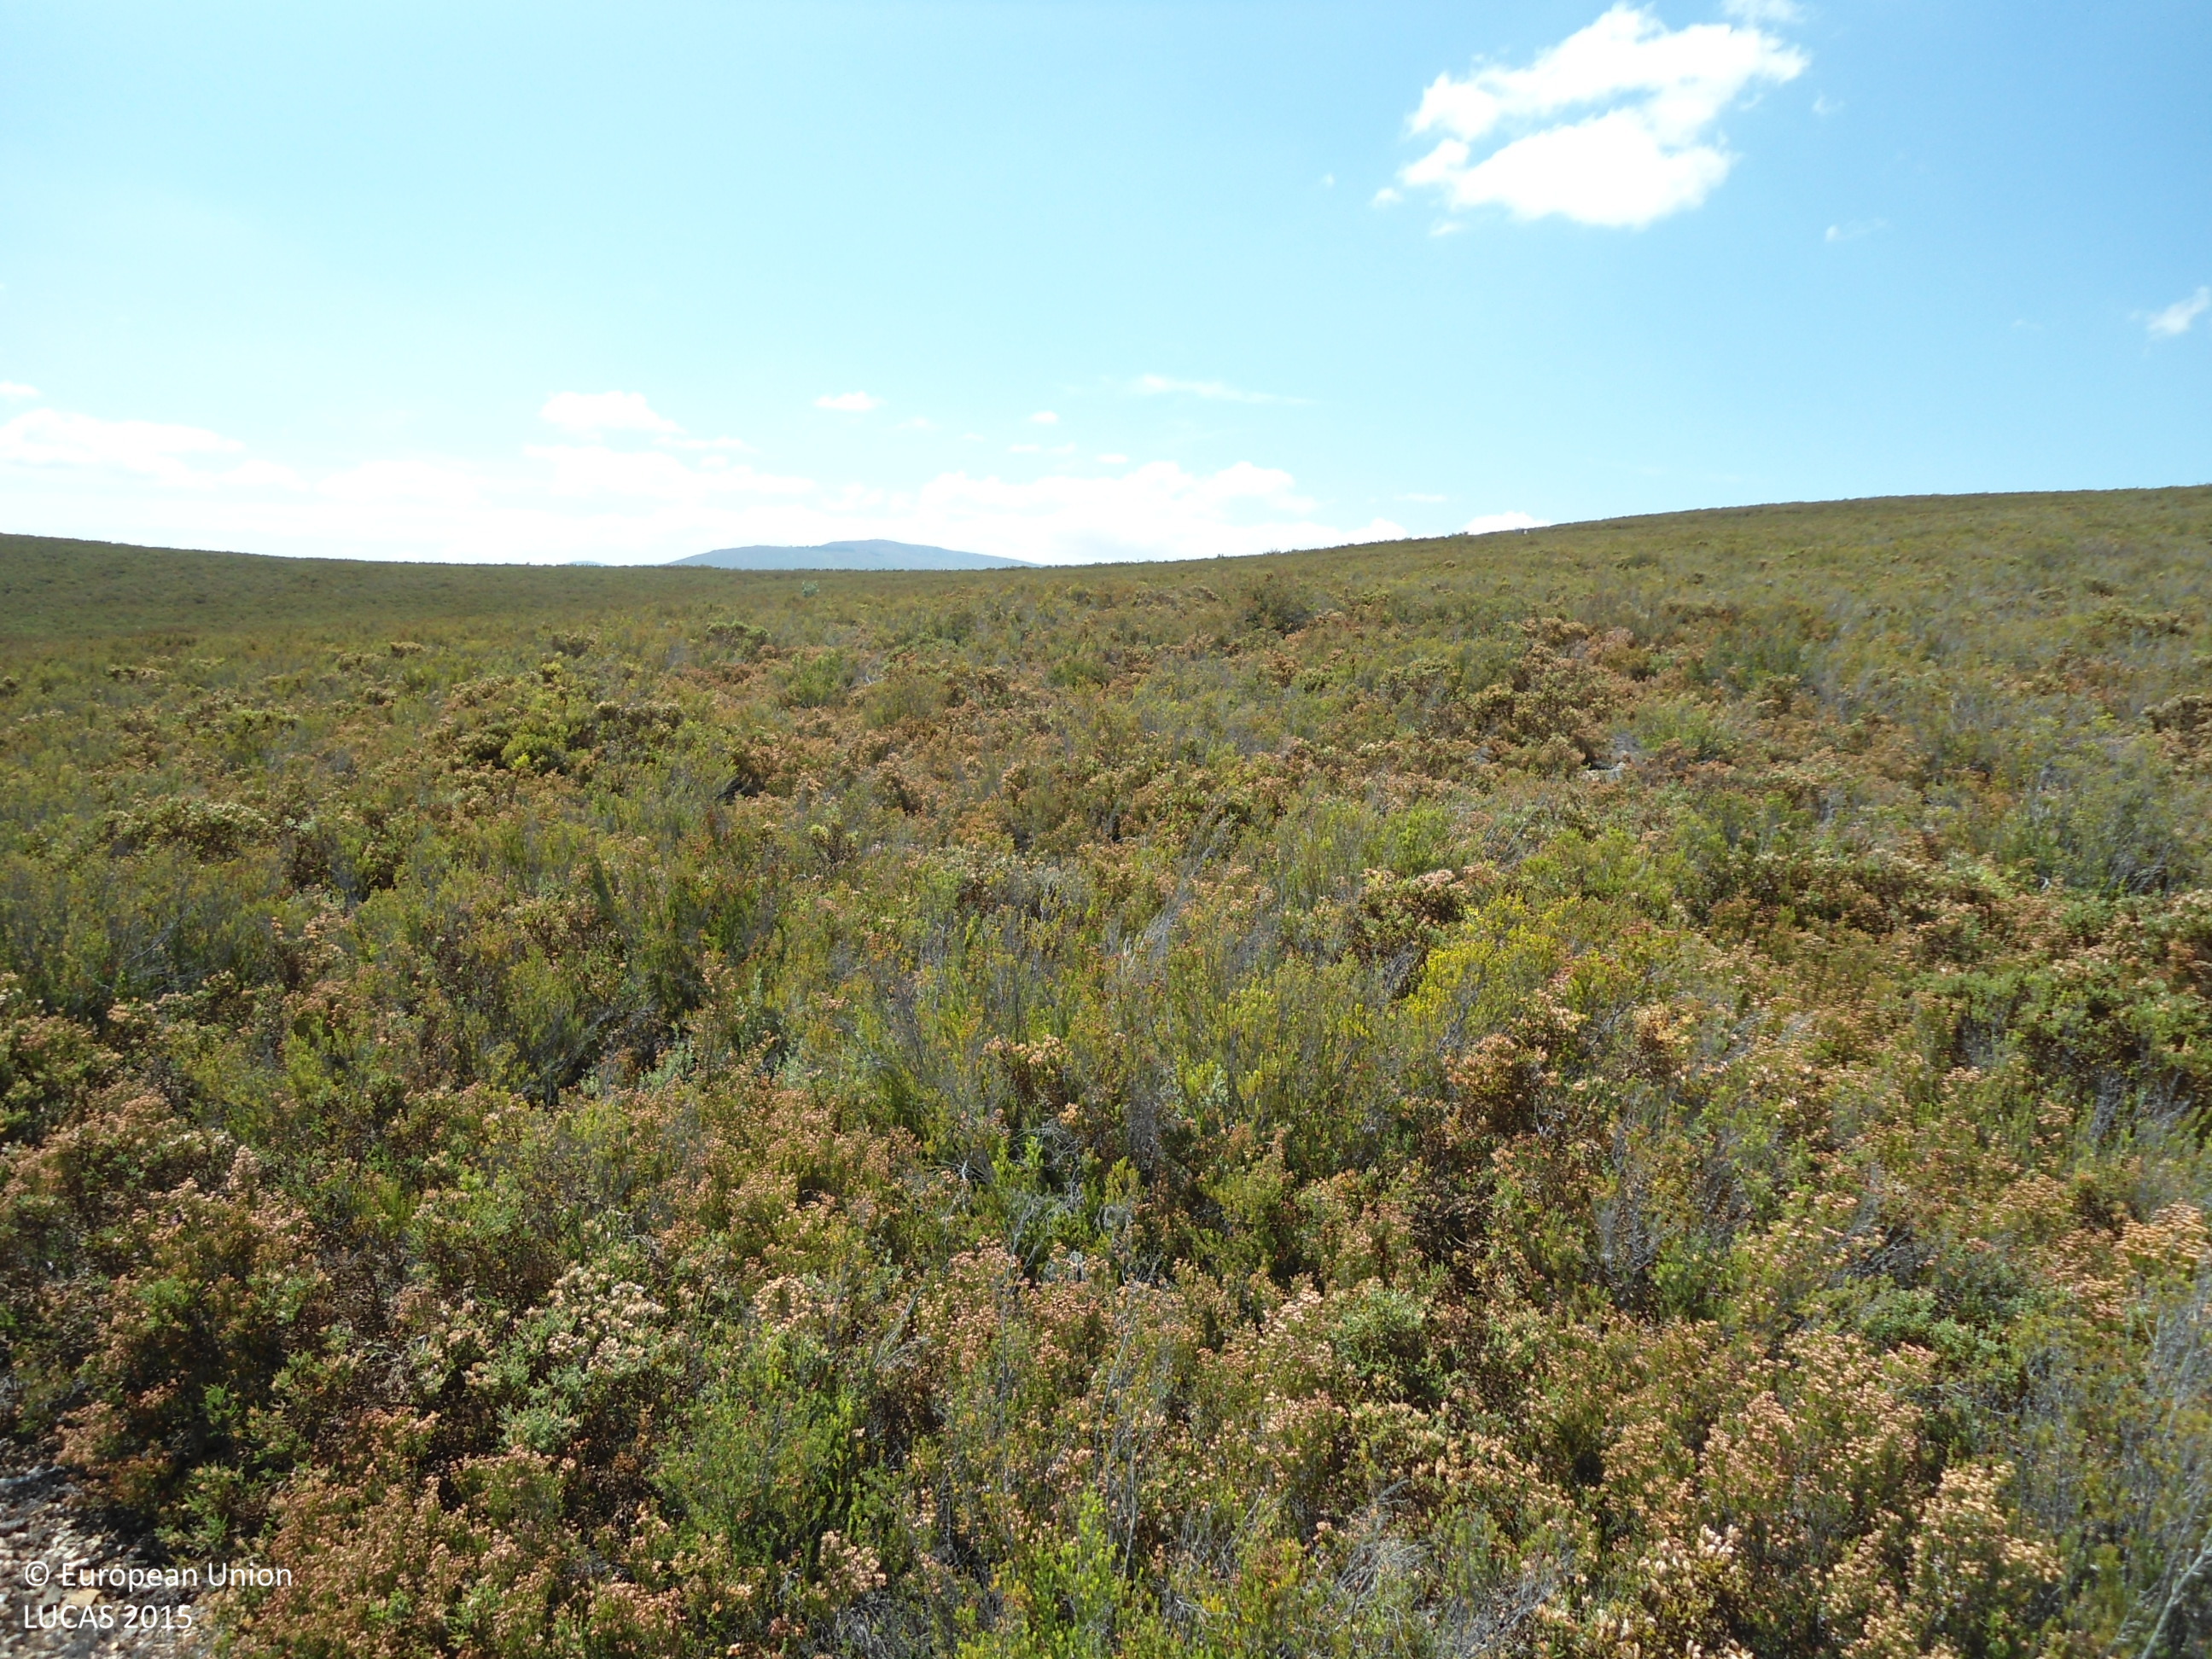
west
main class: Shrubland
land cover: Shrubland without tree cover
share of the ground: > 75 %
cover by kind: shrubs 95 %, consolidated bare surface 5 %
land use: Semi-natural and natural areas not in use
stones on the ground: > 50 %
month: June
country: ES
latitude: 42.1409
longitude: -6.5812
